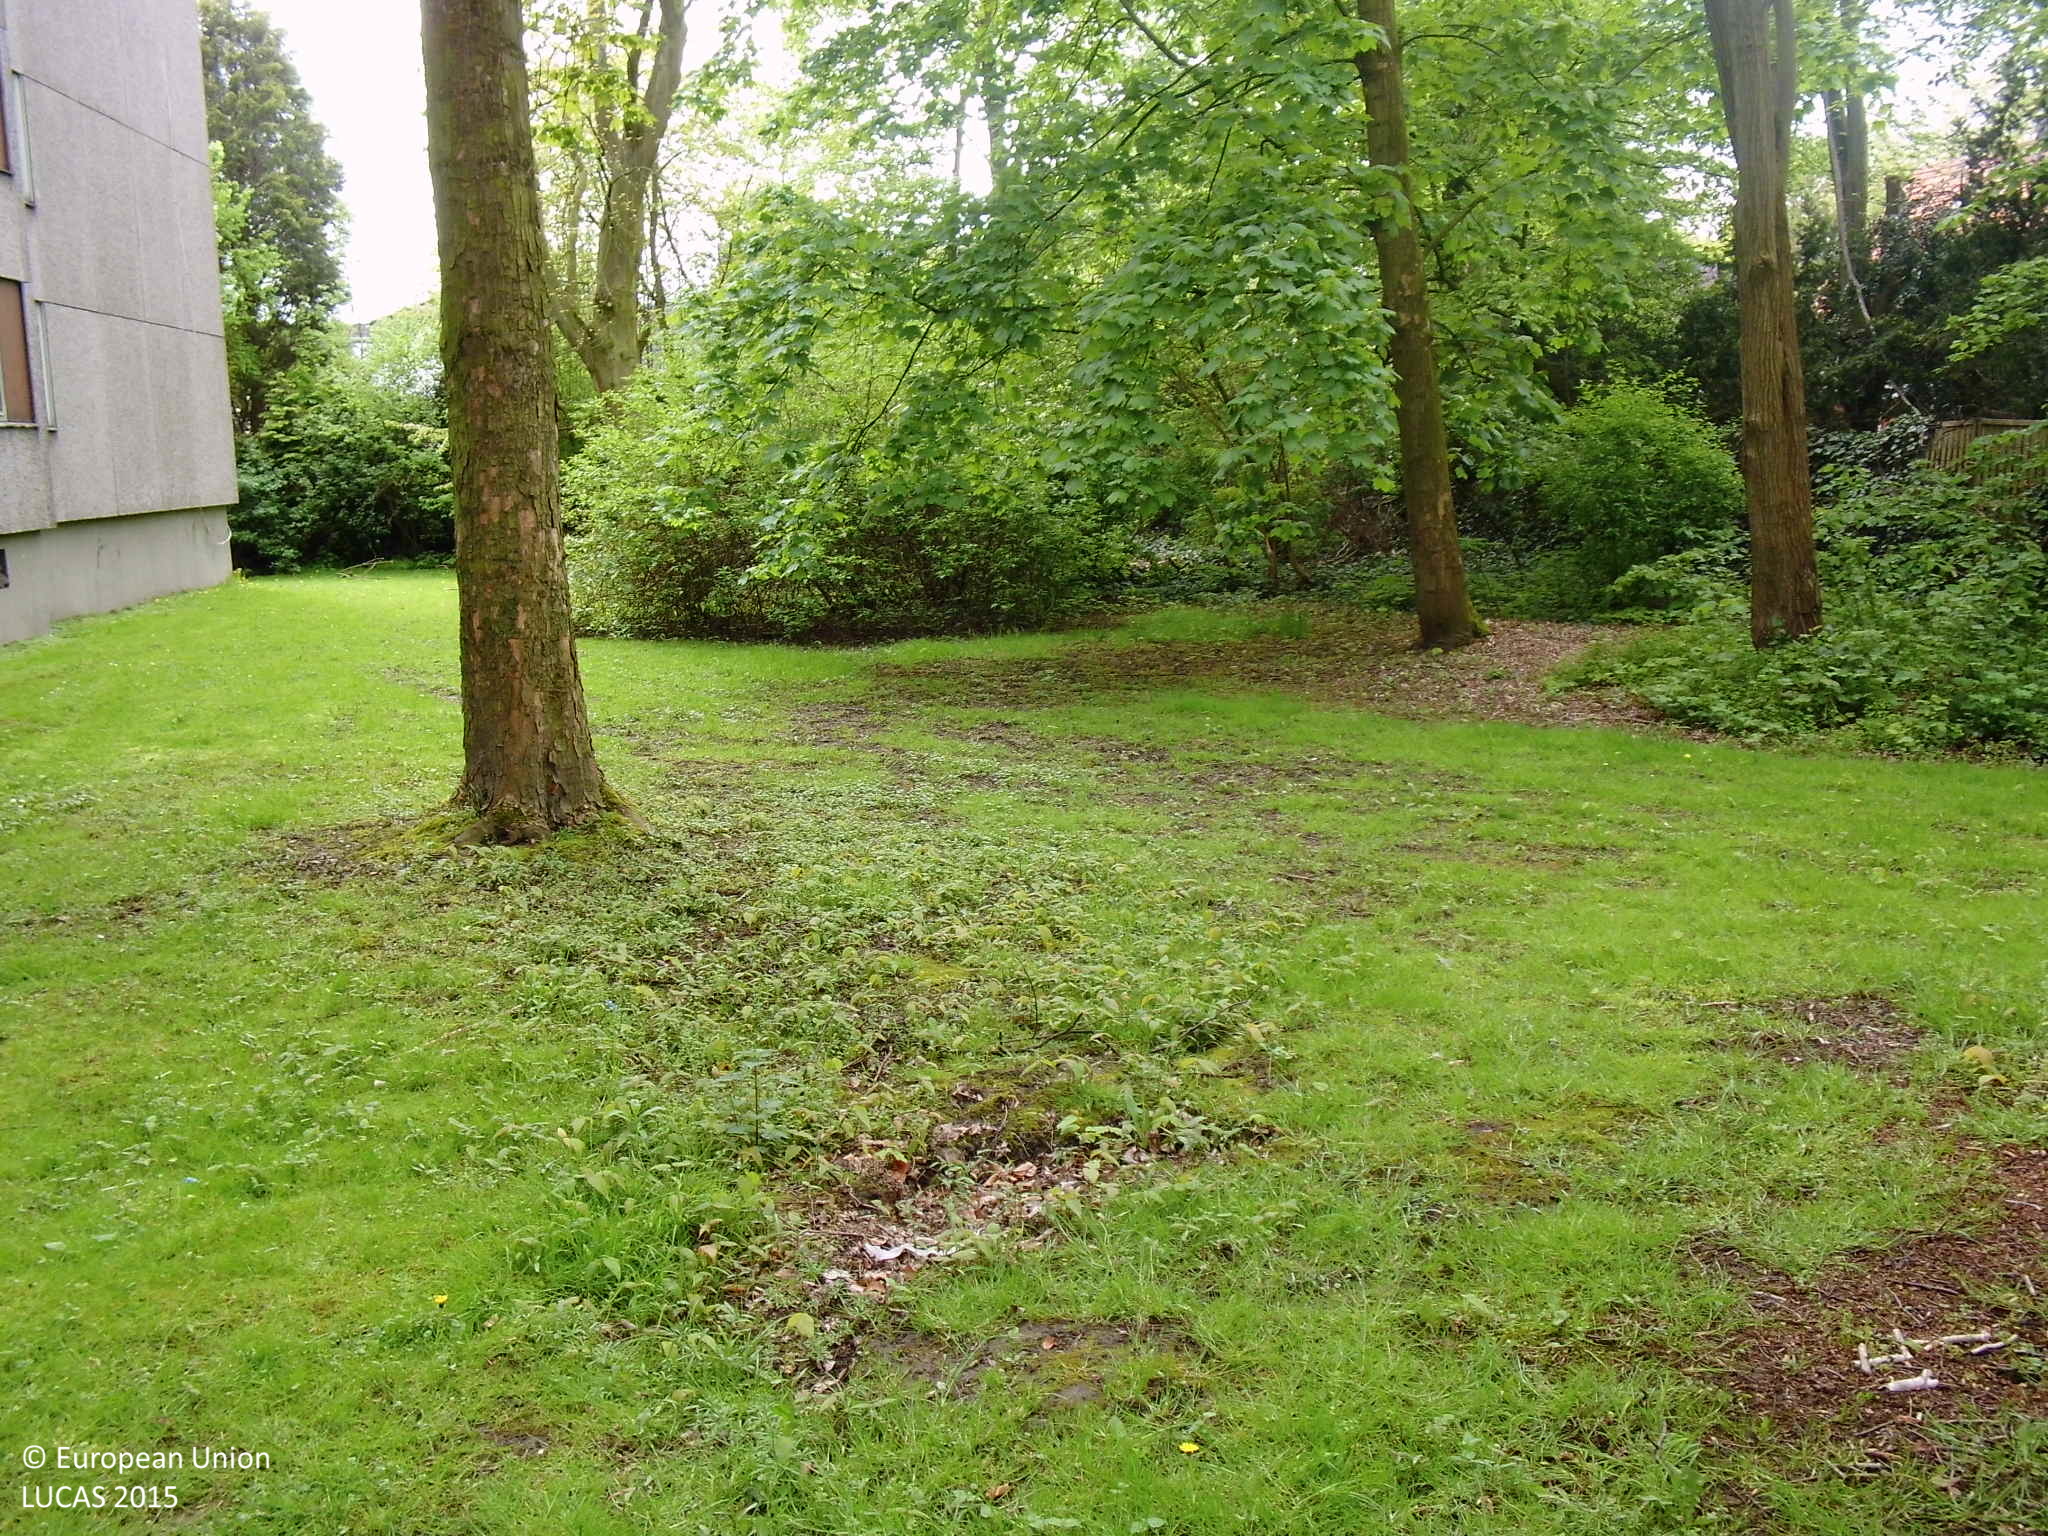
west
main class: Woodland
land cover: Broadleaved woodland
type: mesophytic deciduous forest
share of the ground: > 75 %
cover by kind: broadleaved forest trees 75 %, shrubs 10 %, herbaceous plants 10 %, unconsolidated bare surface 5 %
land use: Residential
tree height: > 5 m
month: May
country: DE
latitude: 51.5575
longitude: 7.3895
